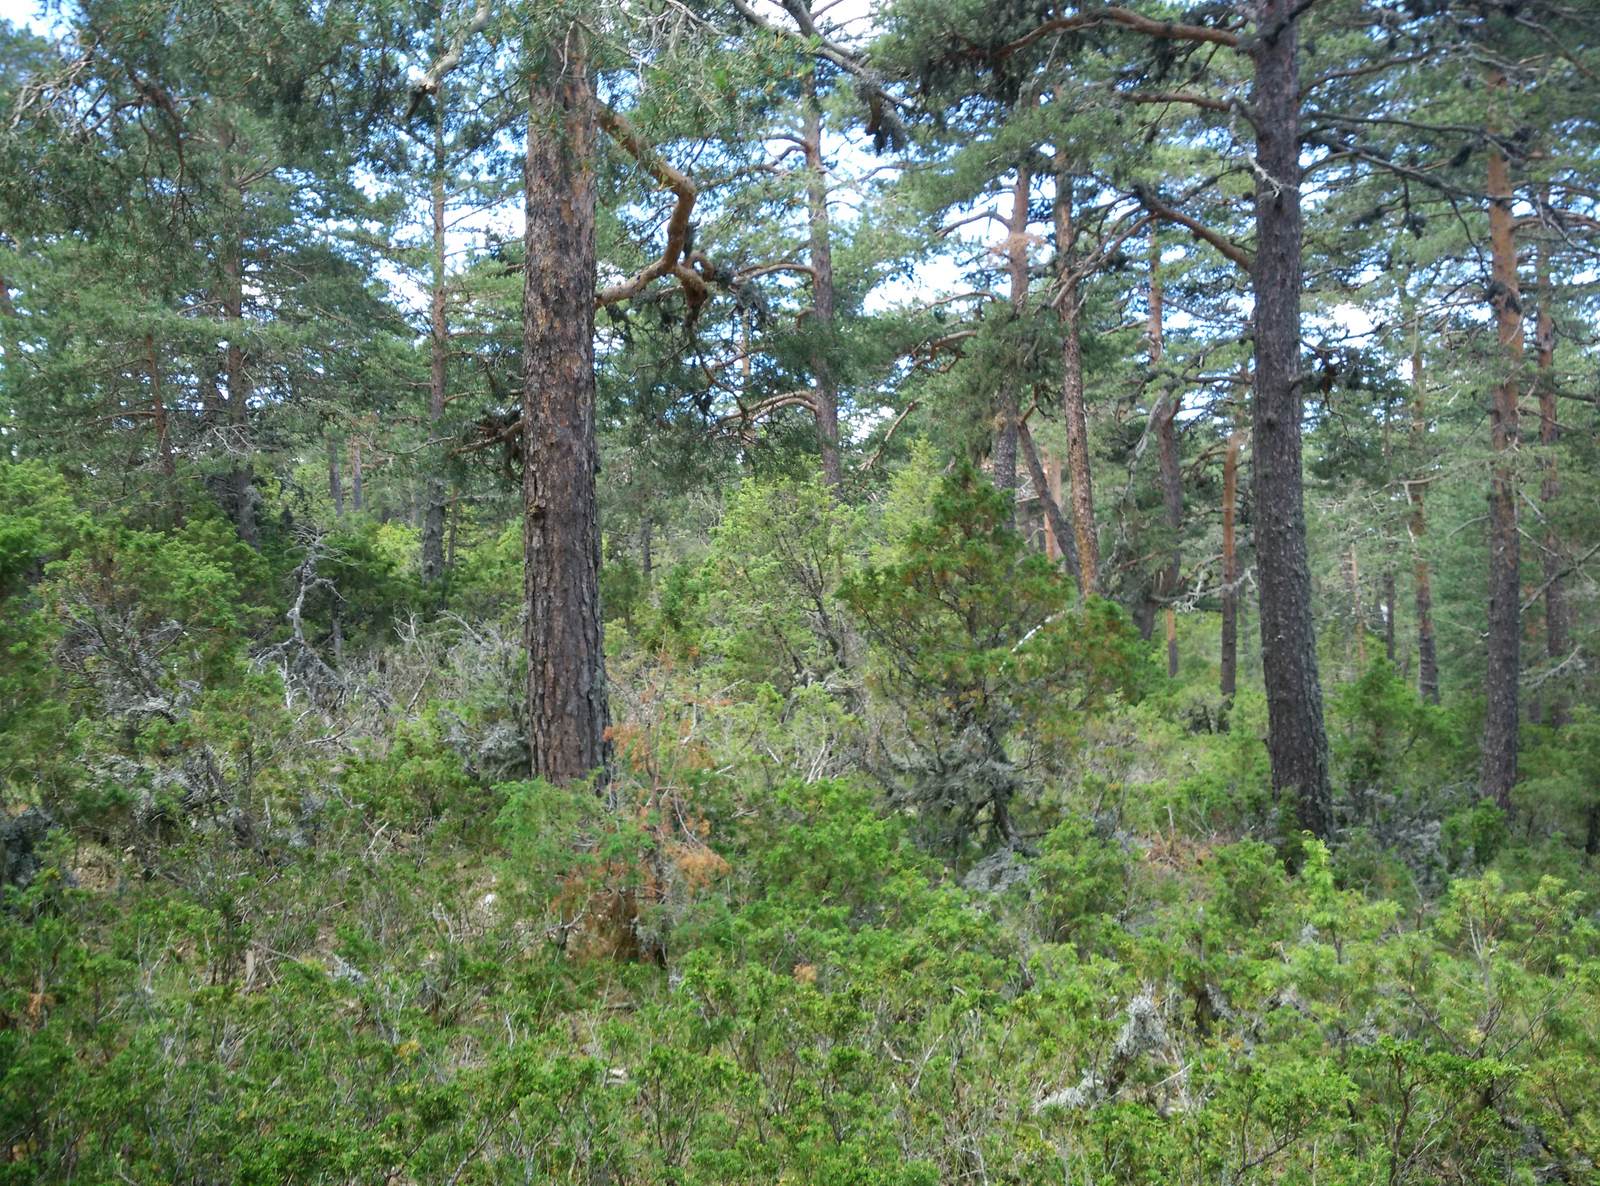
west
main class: Woodland
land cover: Pine dominated coniferous woodland
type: coniferous forest of the mediterranean region
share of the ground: 10 - 25 %
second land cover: Shrubland without tree cover
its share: 10 - 25 %
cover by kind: unconsolidated bare surface 45 %, coniferous forest trees 20 %, shrubs 20 %, herbaceous plants 10 %, lichens and mosses 5 %
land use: Forestry
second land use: Agriculture (excluding fallow land and kitchen gardens)
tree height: > 5 m
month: June
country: ES
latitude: 40.4591
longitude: -1.7029
